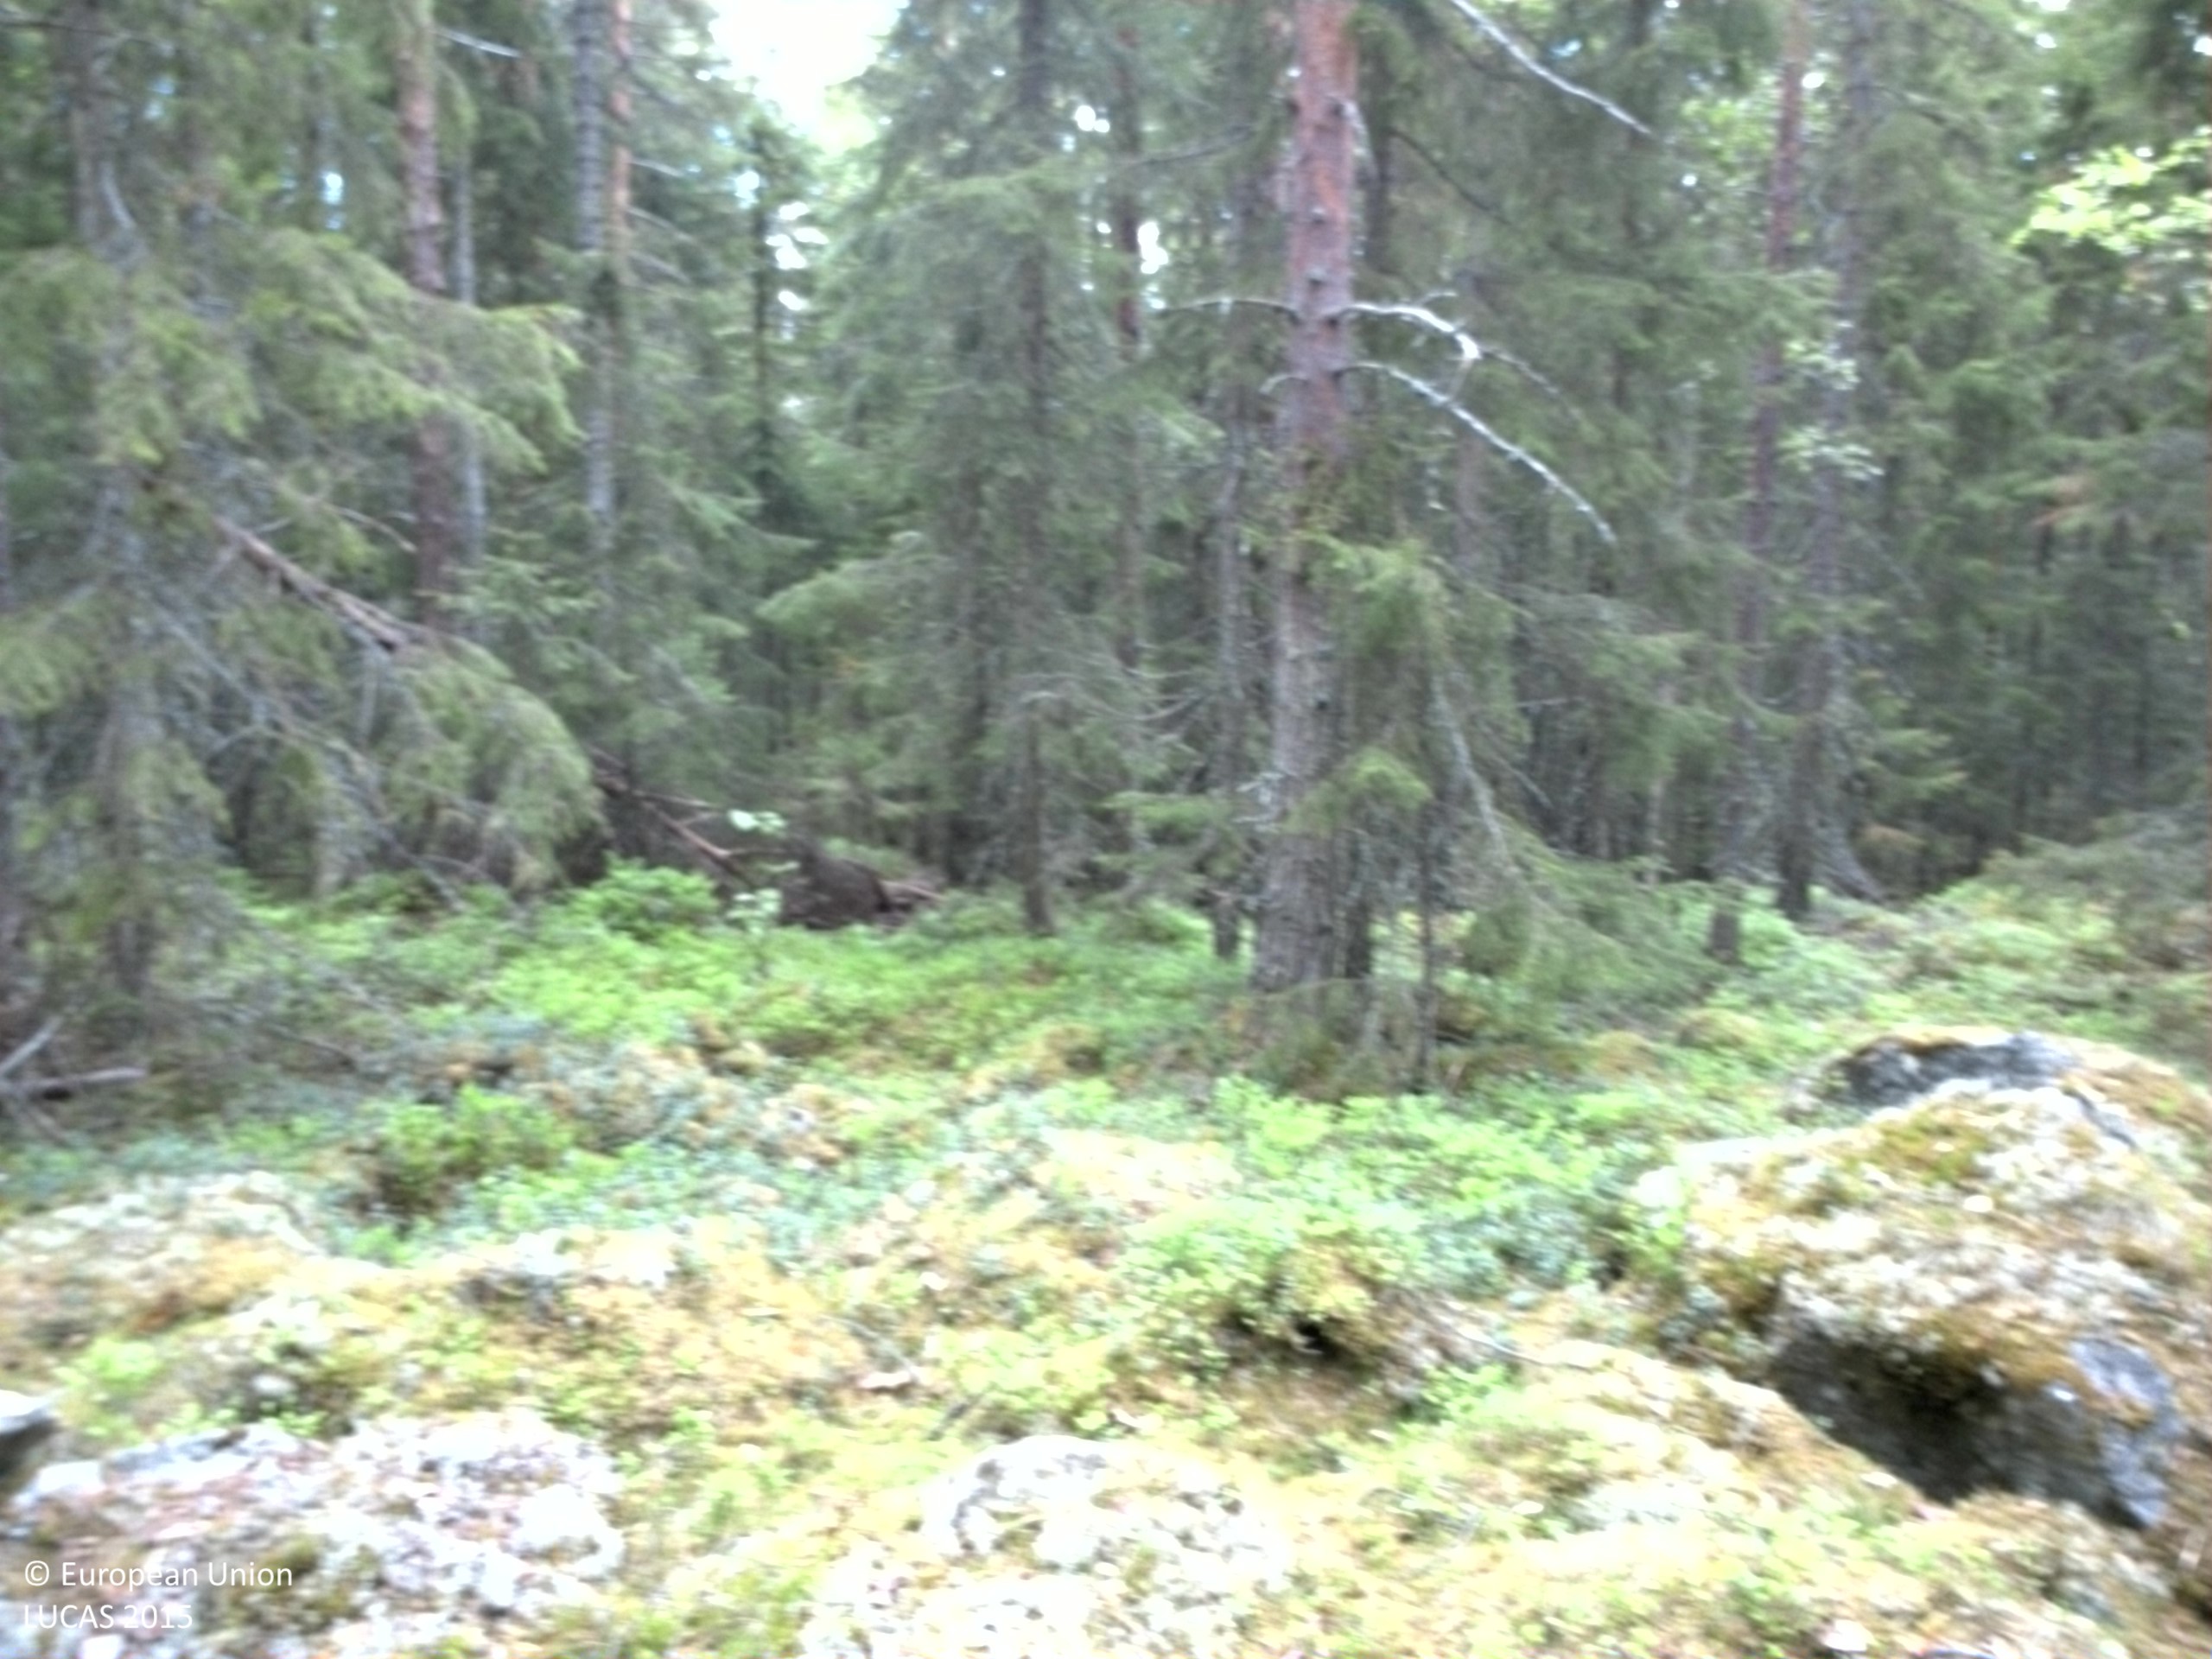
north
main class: Woodland
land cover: Spruce dominated coniferous woodland
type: boreal forest
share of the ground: 50 - 75 %
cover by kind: coniferous forest trees 60 %, shrubs 20 %, lichens and mosses 20 %
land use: Forestry
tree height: > 5 m
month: June
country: SE
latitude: 63.0921
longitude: 17.2054
